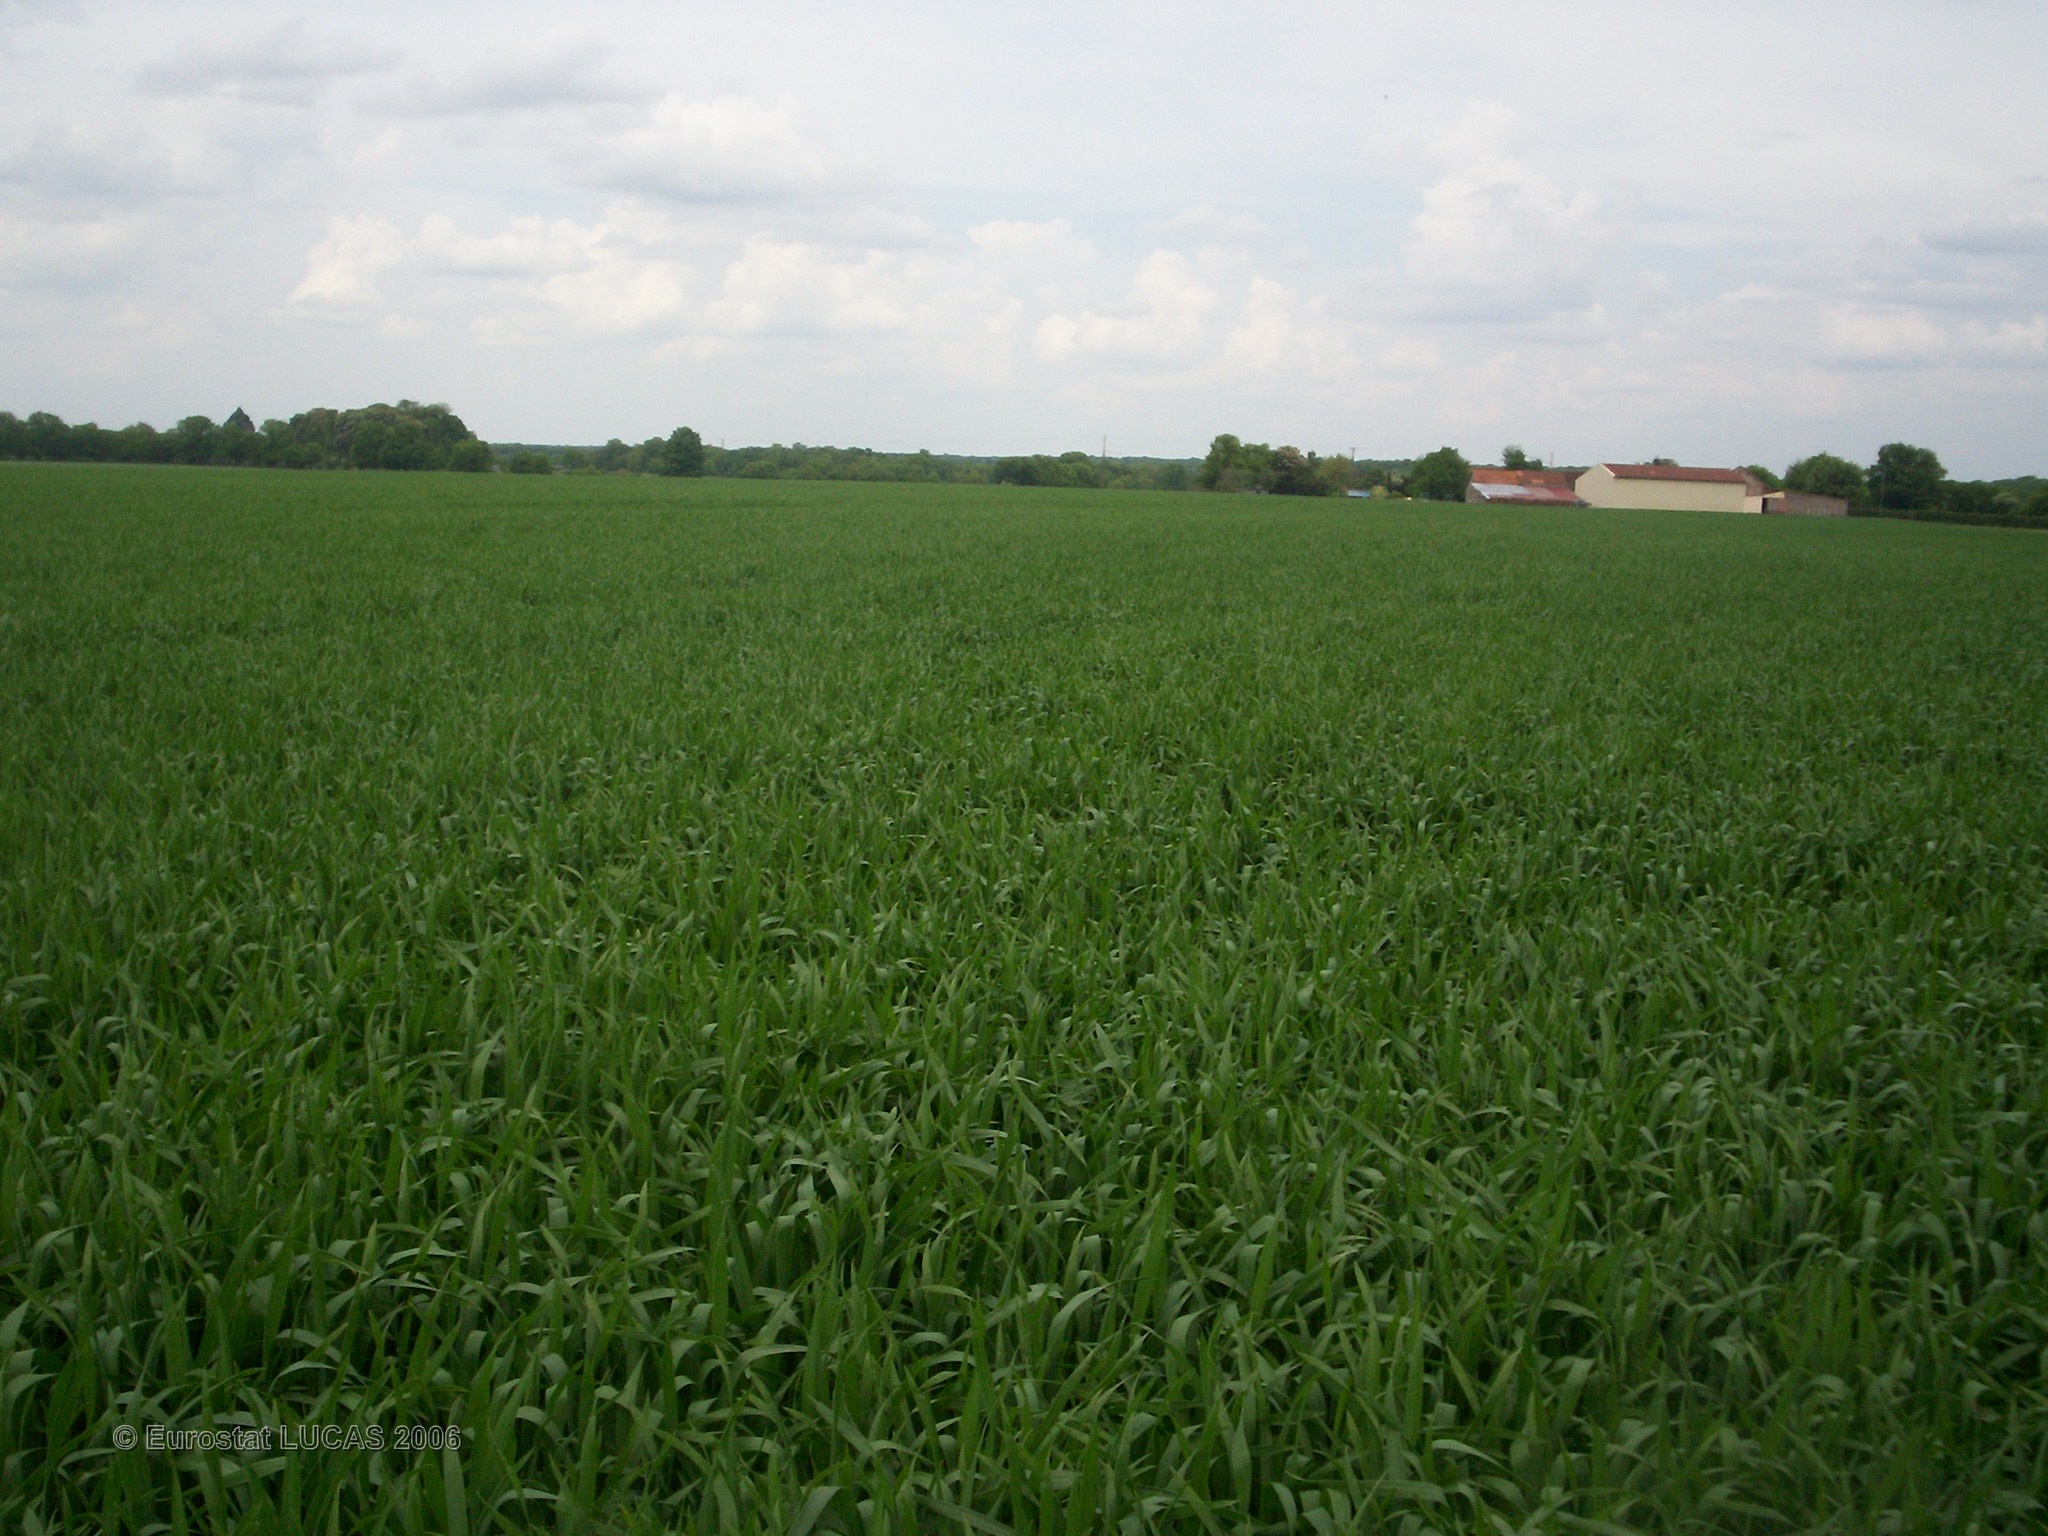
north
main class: Cropland
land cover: Common wheat
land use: Agriculture (excluding fallow land and kitchen gardens)
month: May
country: FR
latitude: 47.6955
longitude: 3.0251
